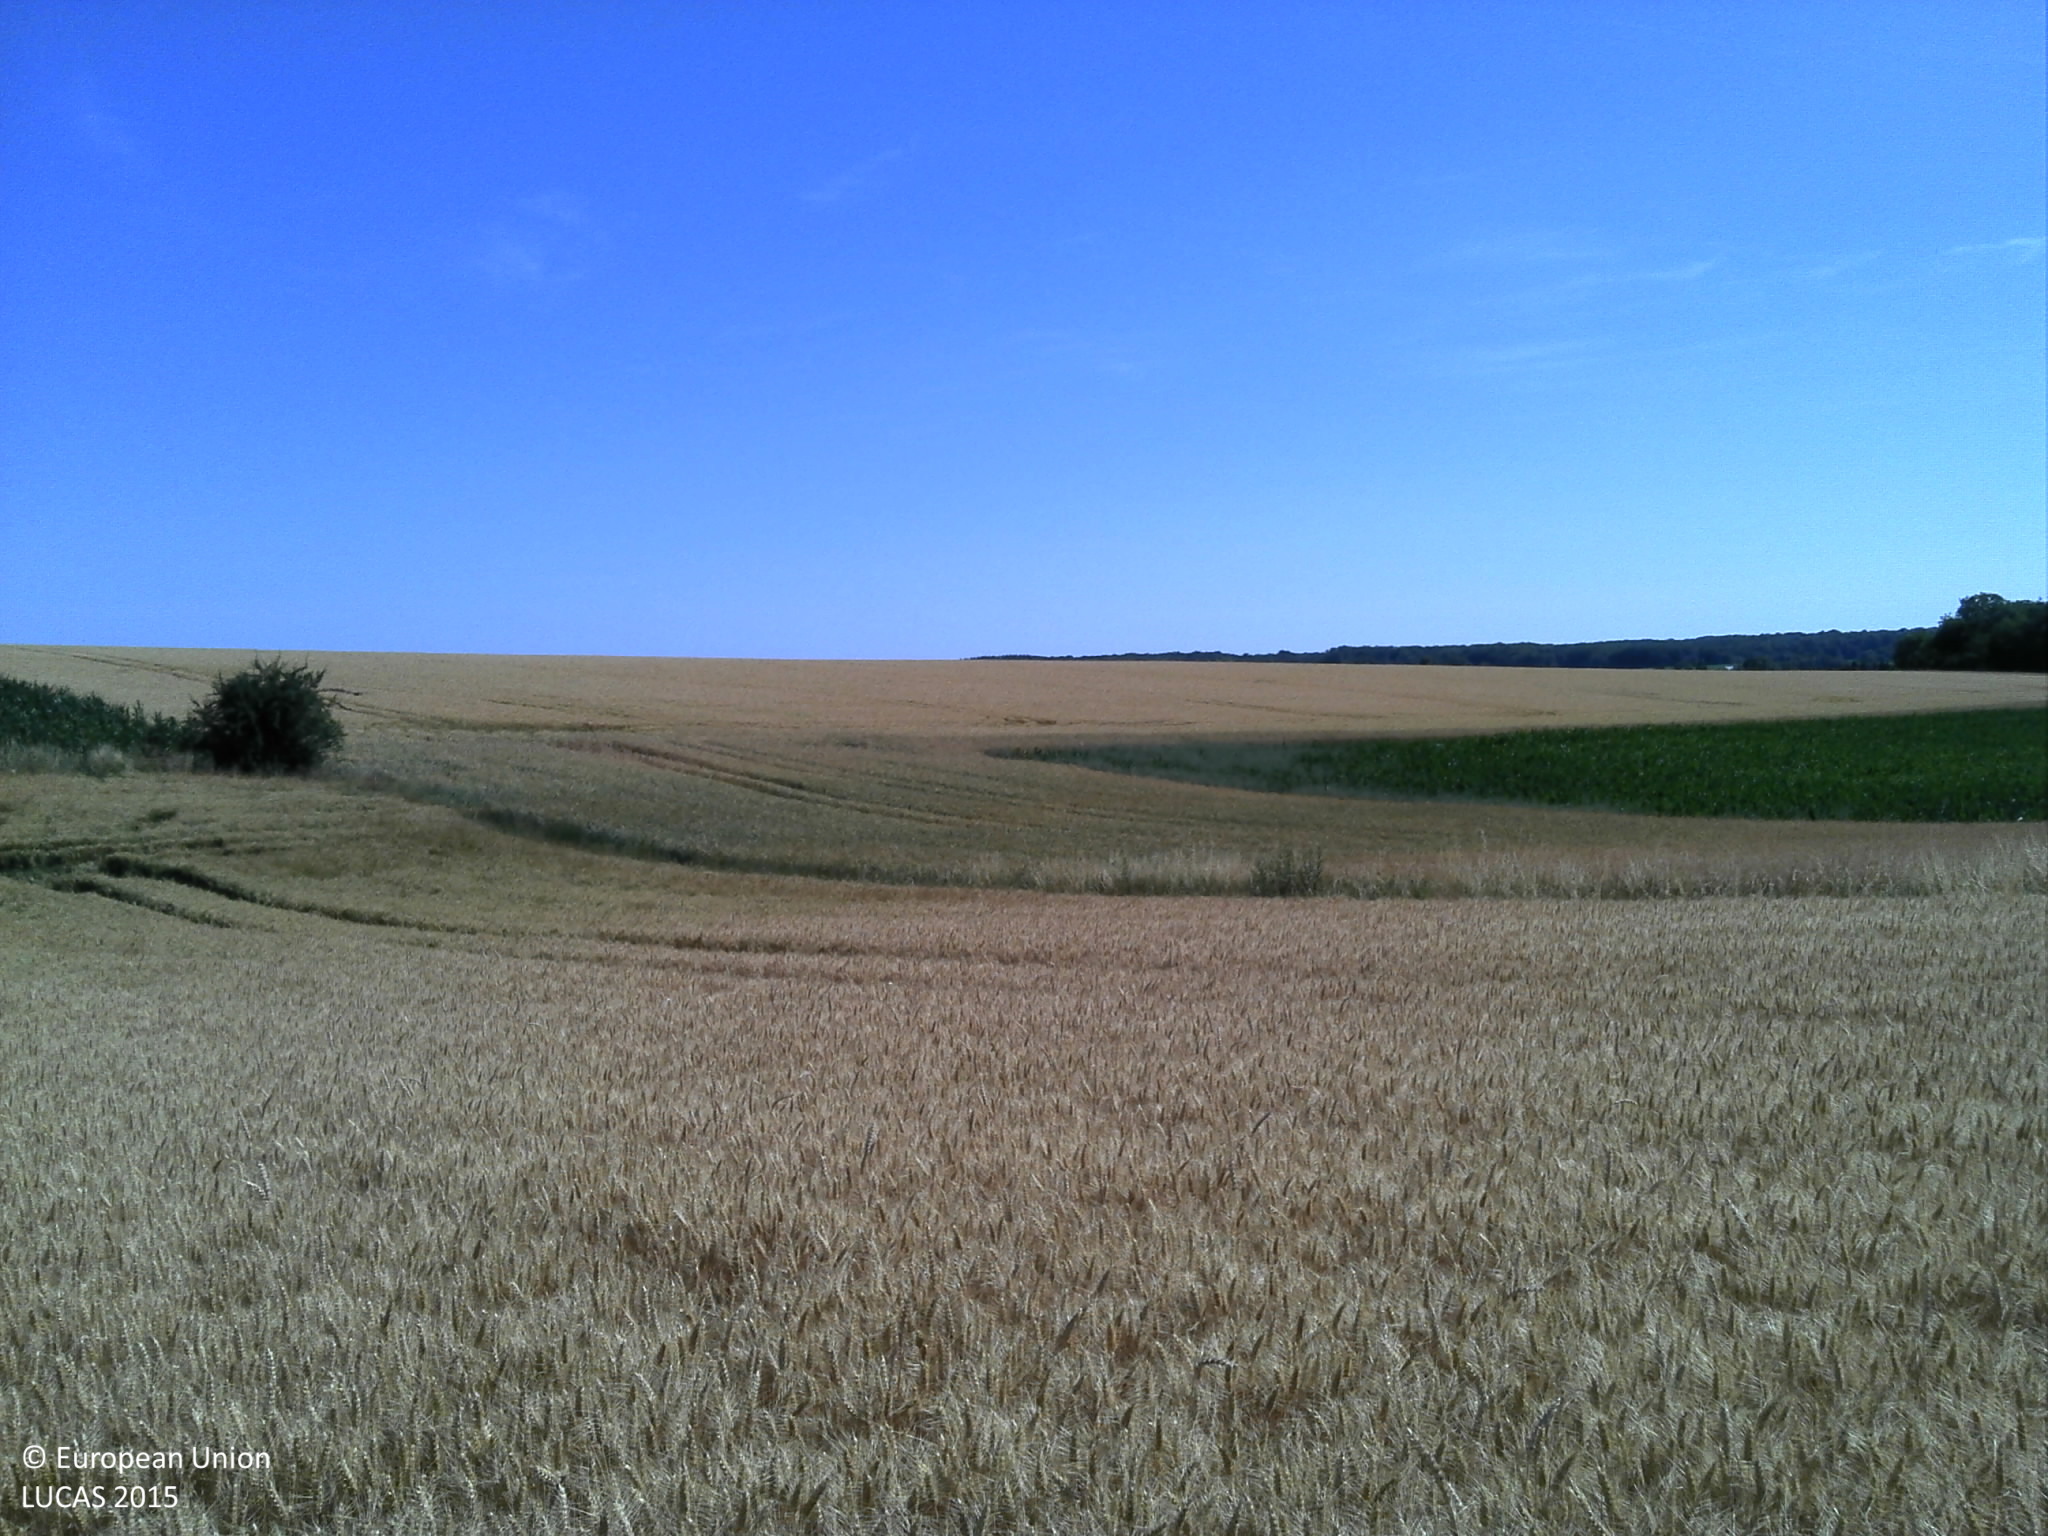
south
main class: Cropland
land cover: Common wheat
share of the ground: > 75 %
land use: Agriculture (excluding fallow land and kitchen gardens)
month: July
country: FR
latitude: 49.5232
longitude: 4.7612
